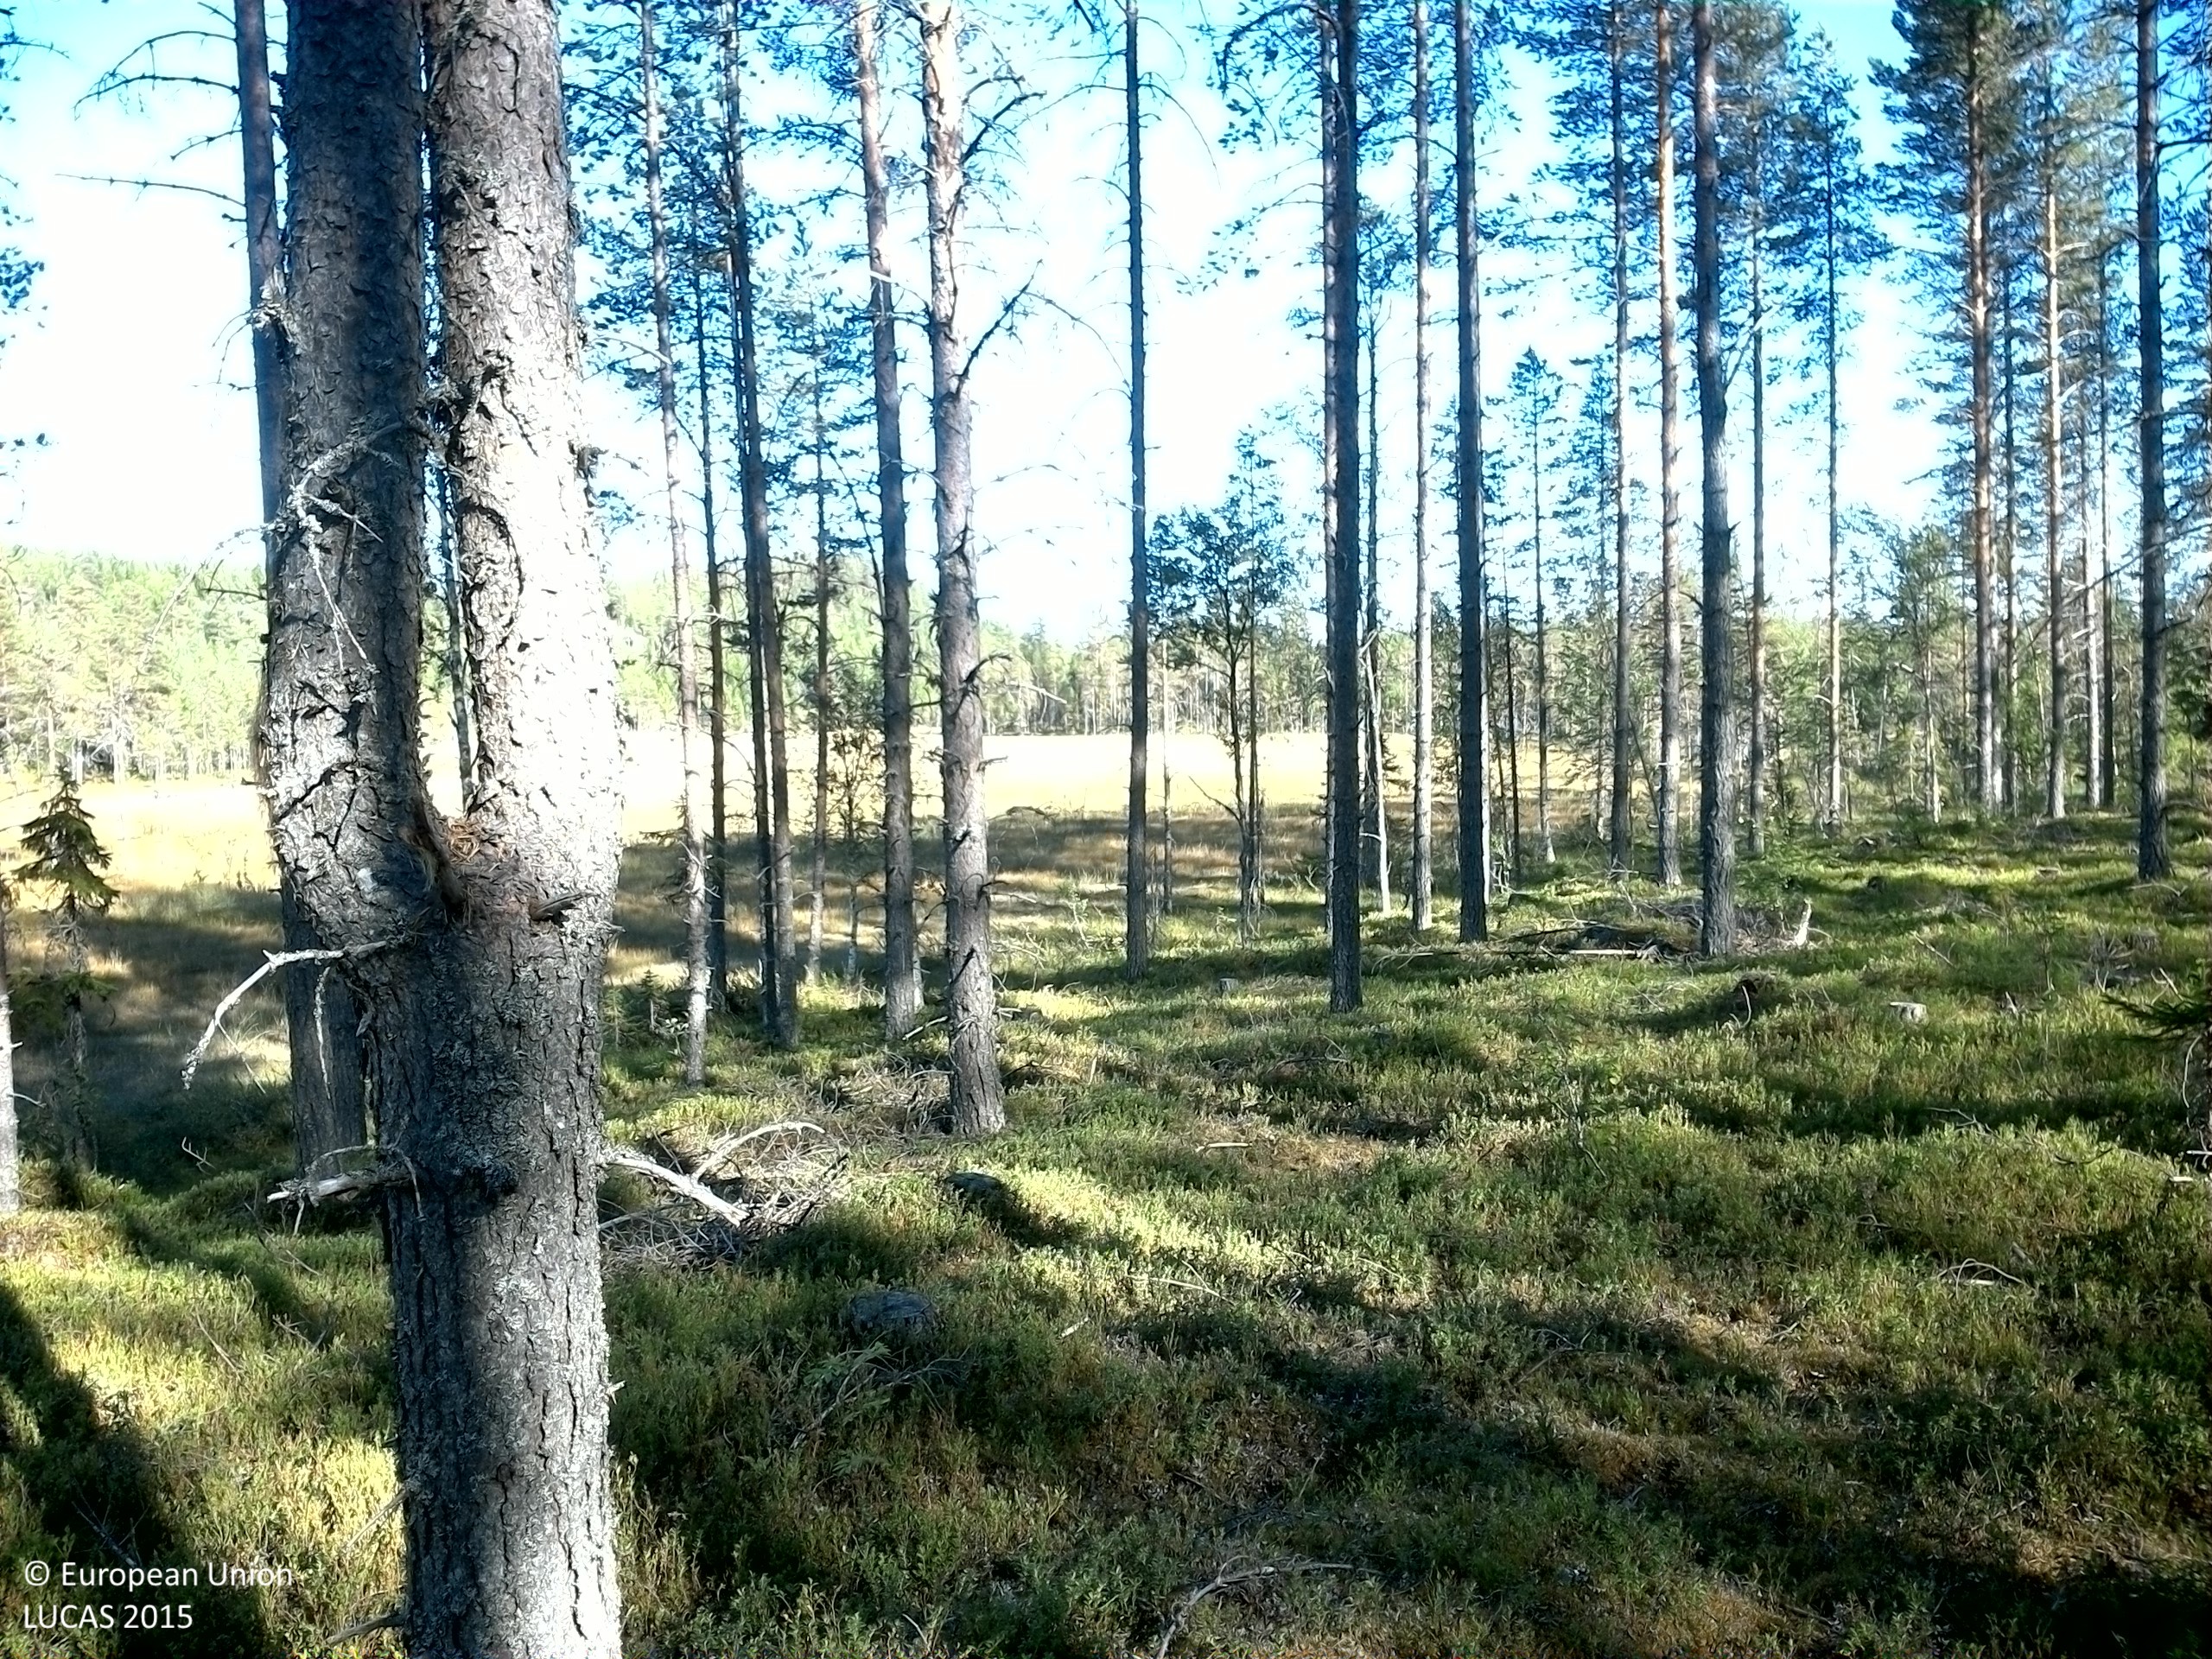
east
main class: Woodland
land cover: Pine dominated coniferous woodland
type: boreal forest
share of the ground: 50 - 75 %
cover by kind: coniferous forest trees 55 %, shrubs 45 %
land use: Forestry
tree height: > 5 m
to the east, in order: Pine dominated coniferous woodland; Peatbogs; Inland marshes; Peatbogs
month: August
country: SE
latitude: 63.8908
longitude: 17.5681
